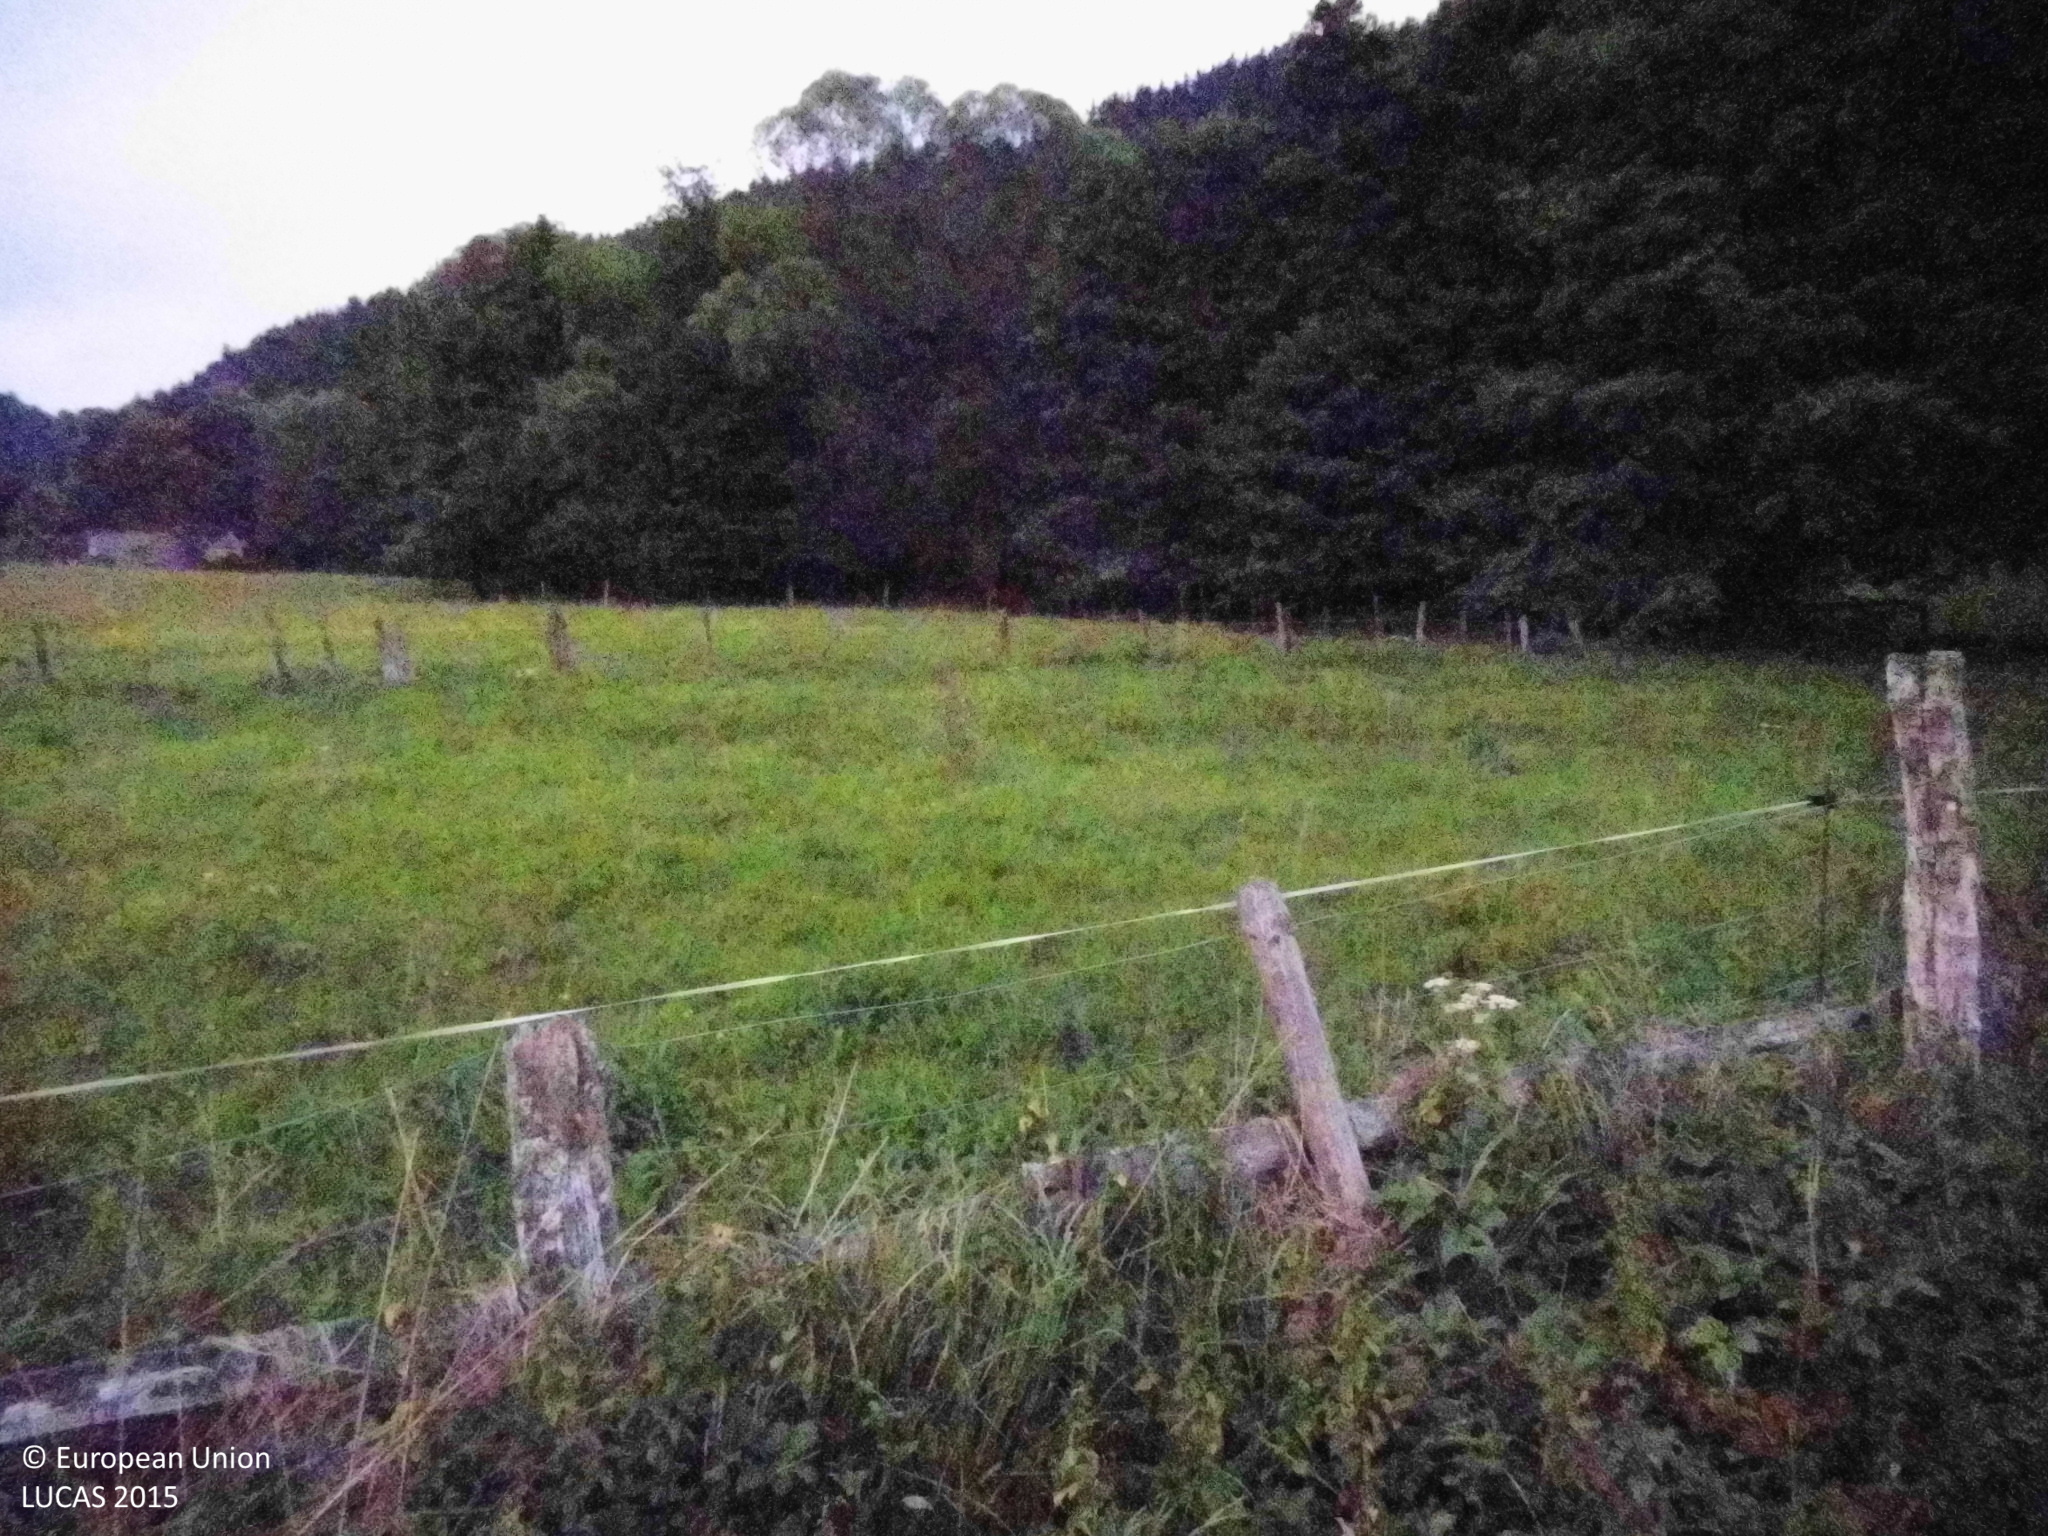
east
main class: Grassland
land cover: Grassland without tree/shrub cover
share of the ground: > 75 %
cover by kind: herbaceous plants 95 %, unconsolidated bare surface 5 %
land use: Agriculture (excluding fallow land and kitchen gardens)
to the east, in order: Grassland without tree/shrub cover; Fences; Grassland without tree/shrub cover; Fences; Grassland without tree/shrub cover; Fences; Broadleaved woodland; Rivers and streams; Fences; Grassland without tree/shrub cover; Fences; Tracks; Broadleaved woodland; Grass margins; Tracks; Groves; Spruce dominated coniferous woodland
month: August
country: DE
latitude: 51.1289
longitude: 8.6143
